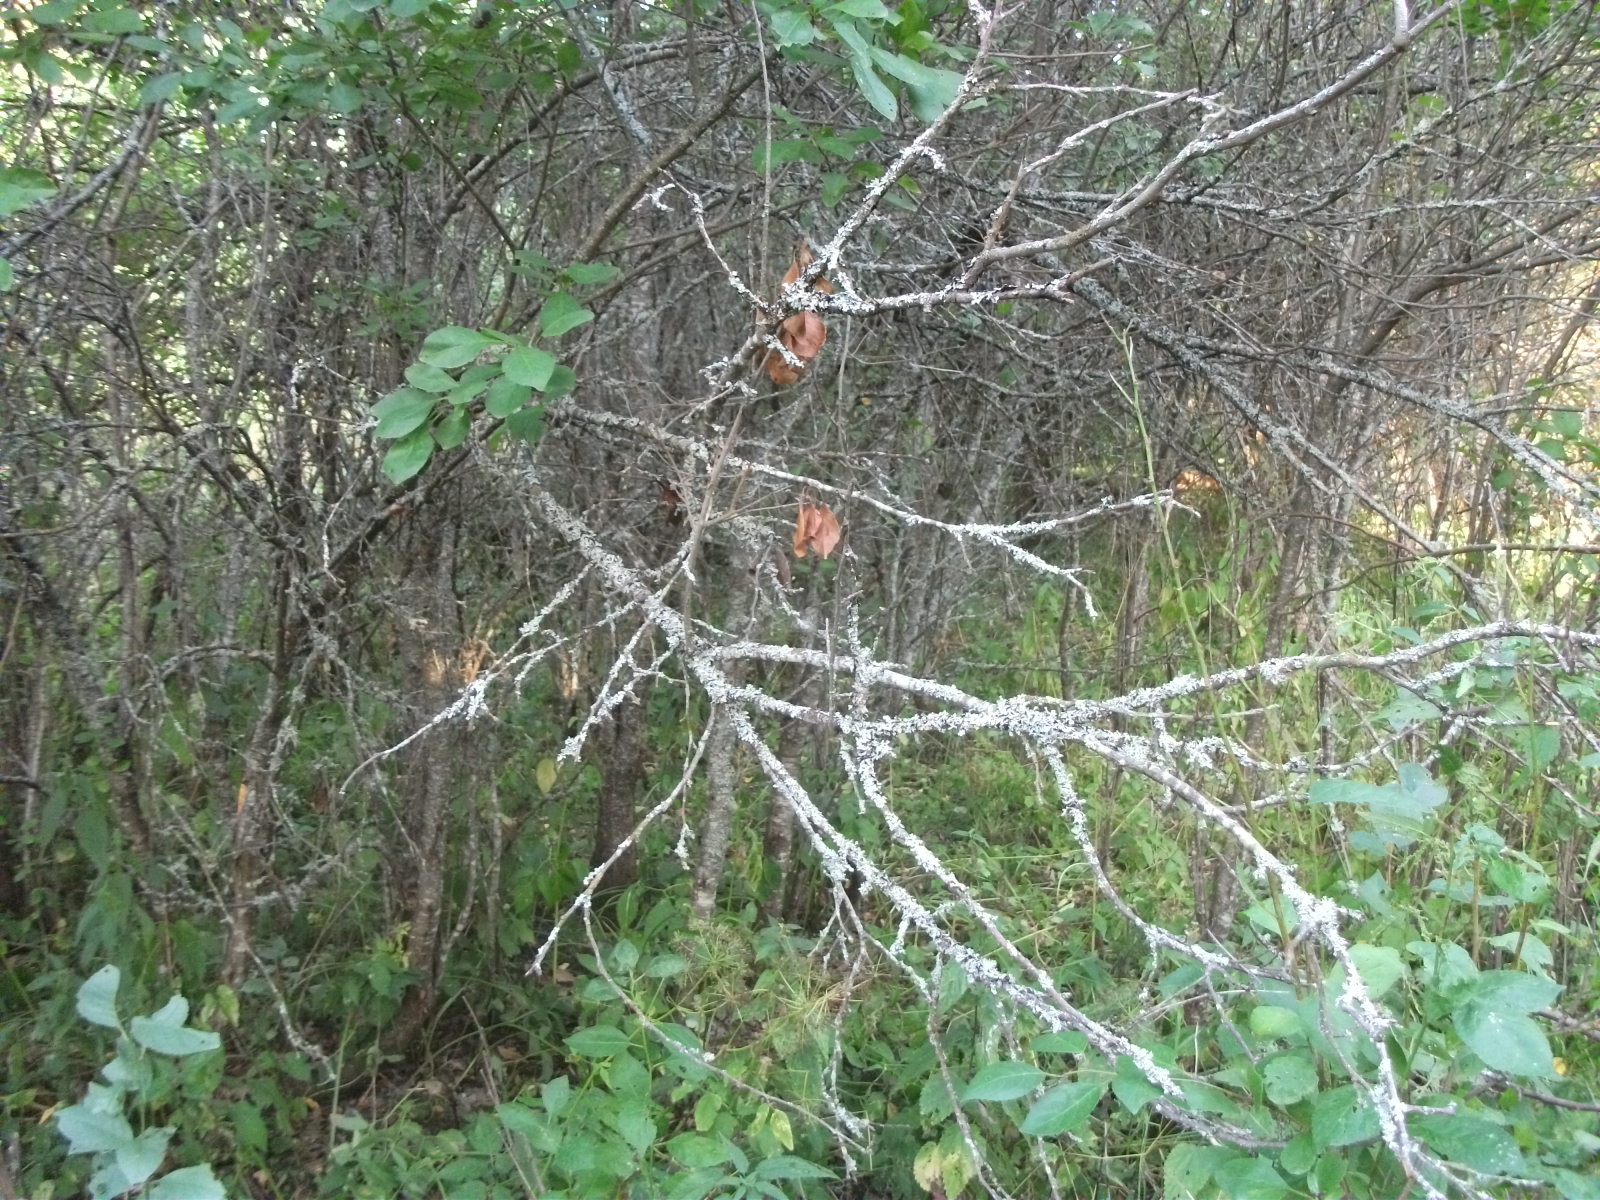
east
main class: Cropland
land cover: Other fruit trees and berries
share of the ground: 25 - 50 %
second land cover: Spontaneously vegetated surfaces
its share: > 75 %
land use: Abandoned areas
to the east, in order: Other fruit trees and berries; Spontaneously vegetated surfaces; Broadleaved woodland; Spontaneously vegetated surfaces; Grassland with sparse tree/shrub cover
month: August
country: LV
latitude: 56.5129
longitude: 26.3119
